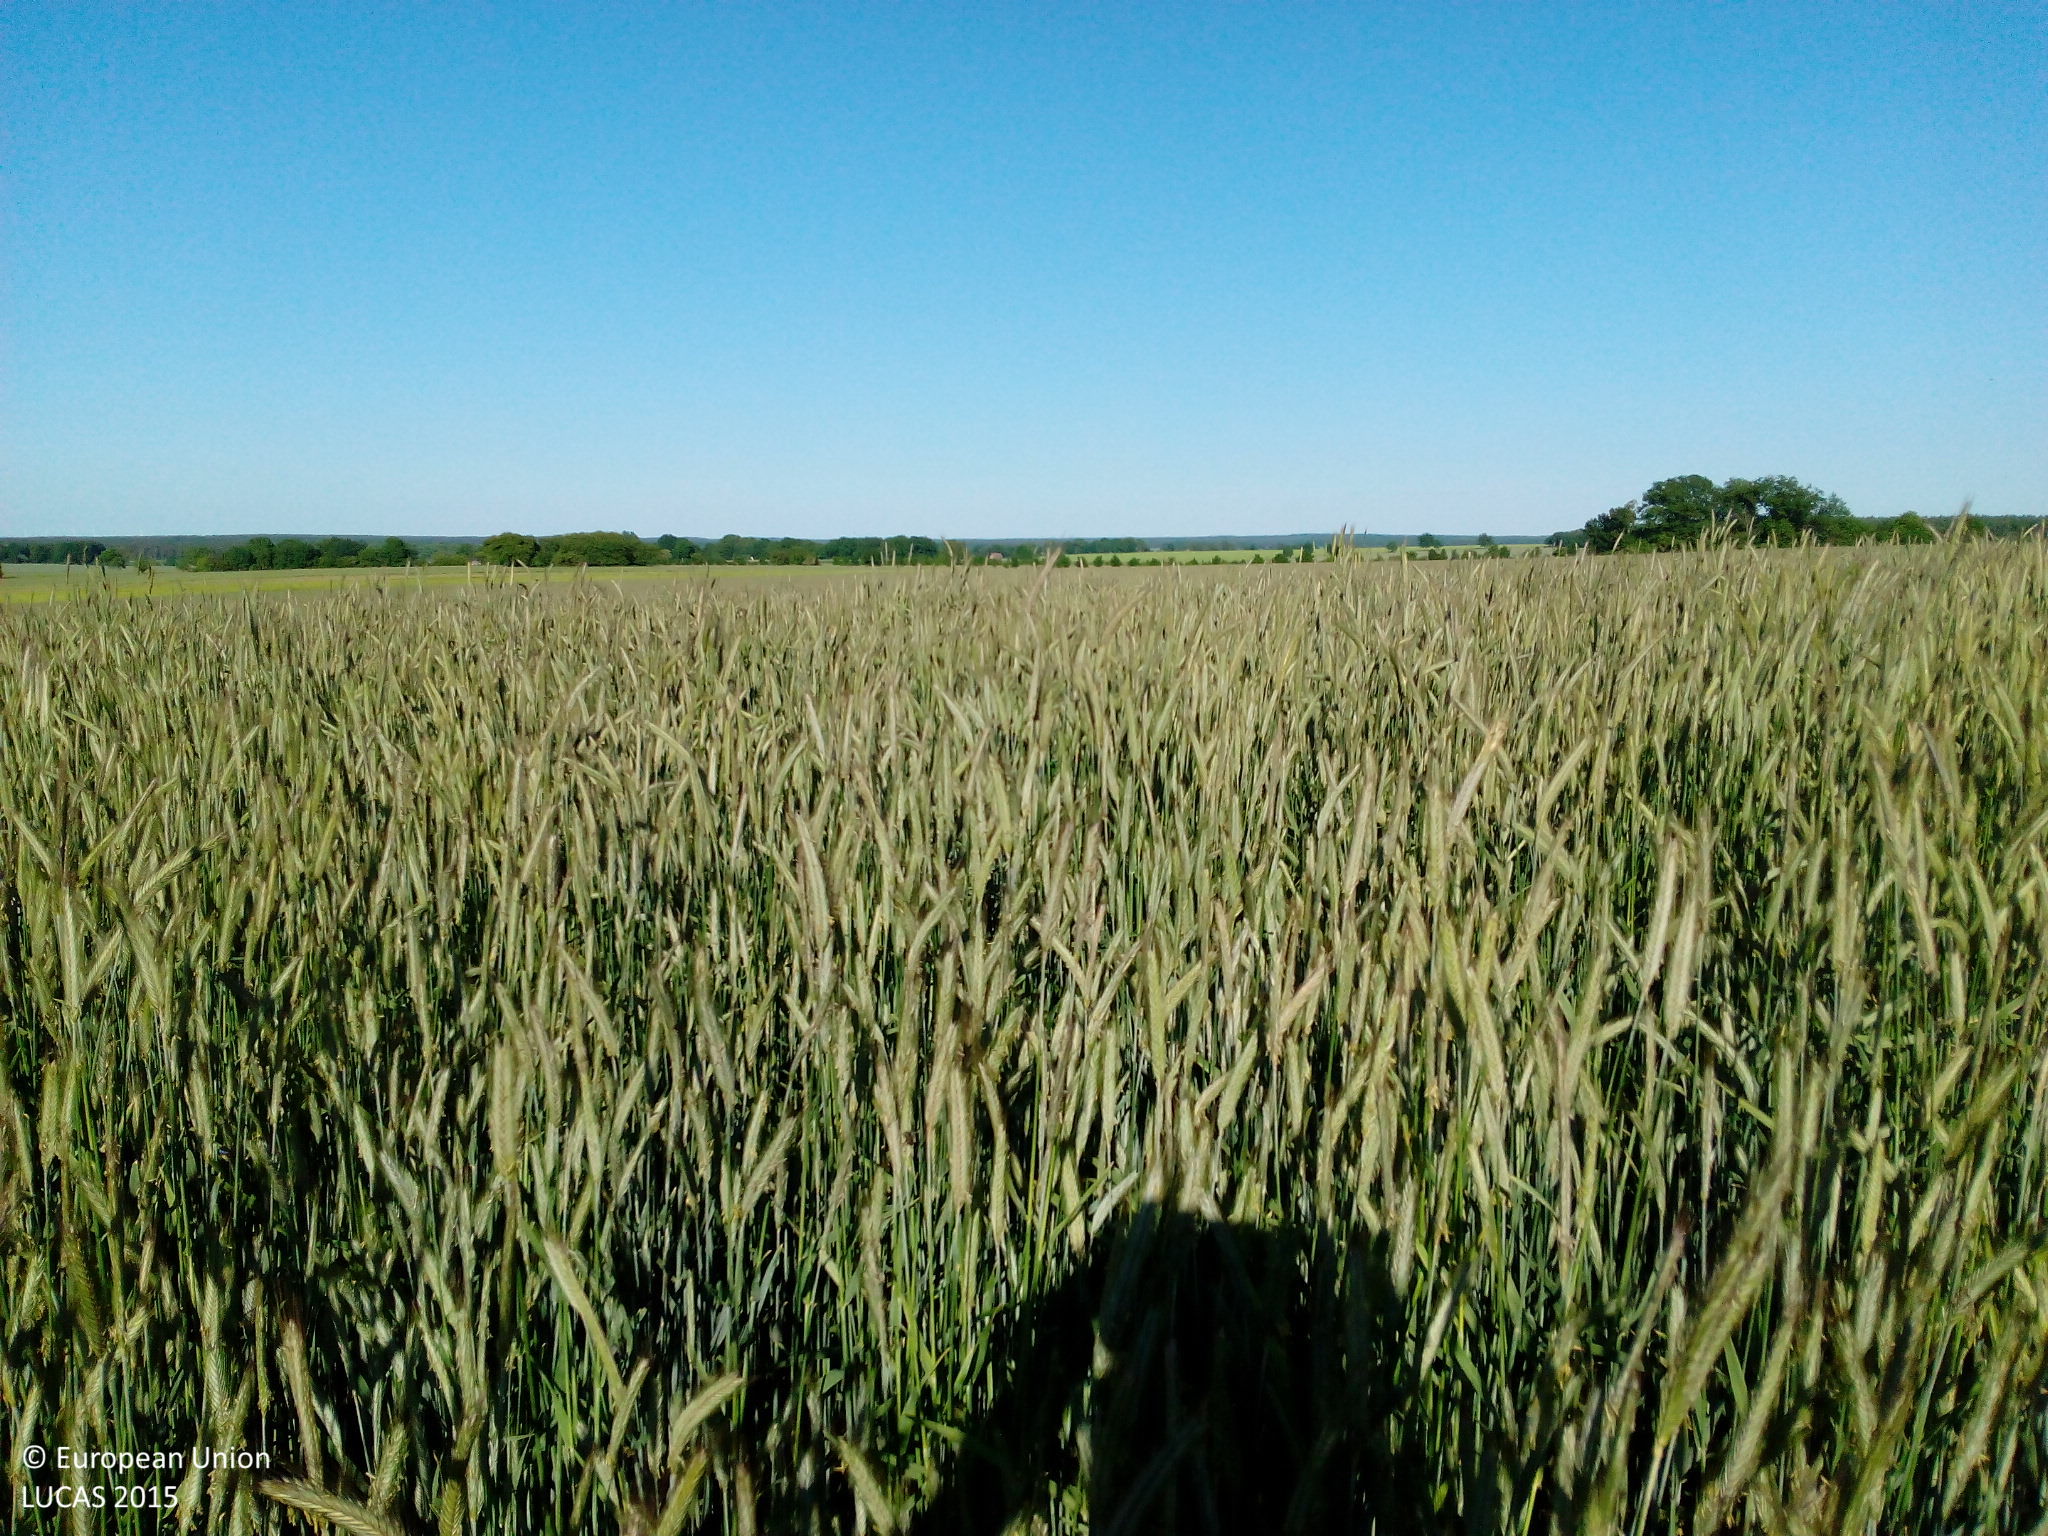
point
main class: Cropland
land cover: Rye
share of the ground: > 75 %
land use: Agriculture (excluding fallow land and kitchen gardens)
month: June
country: DE
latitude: 53.2712
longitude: 12.3535
